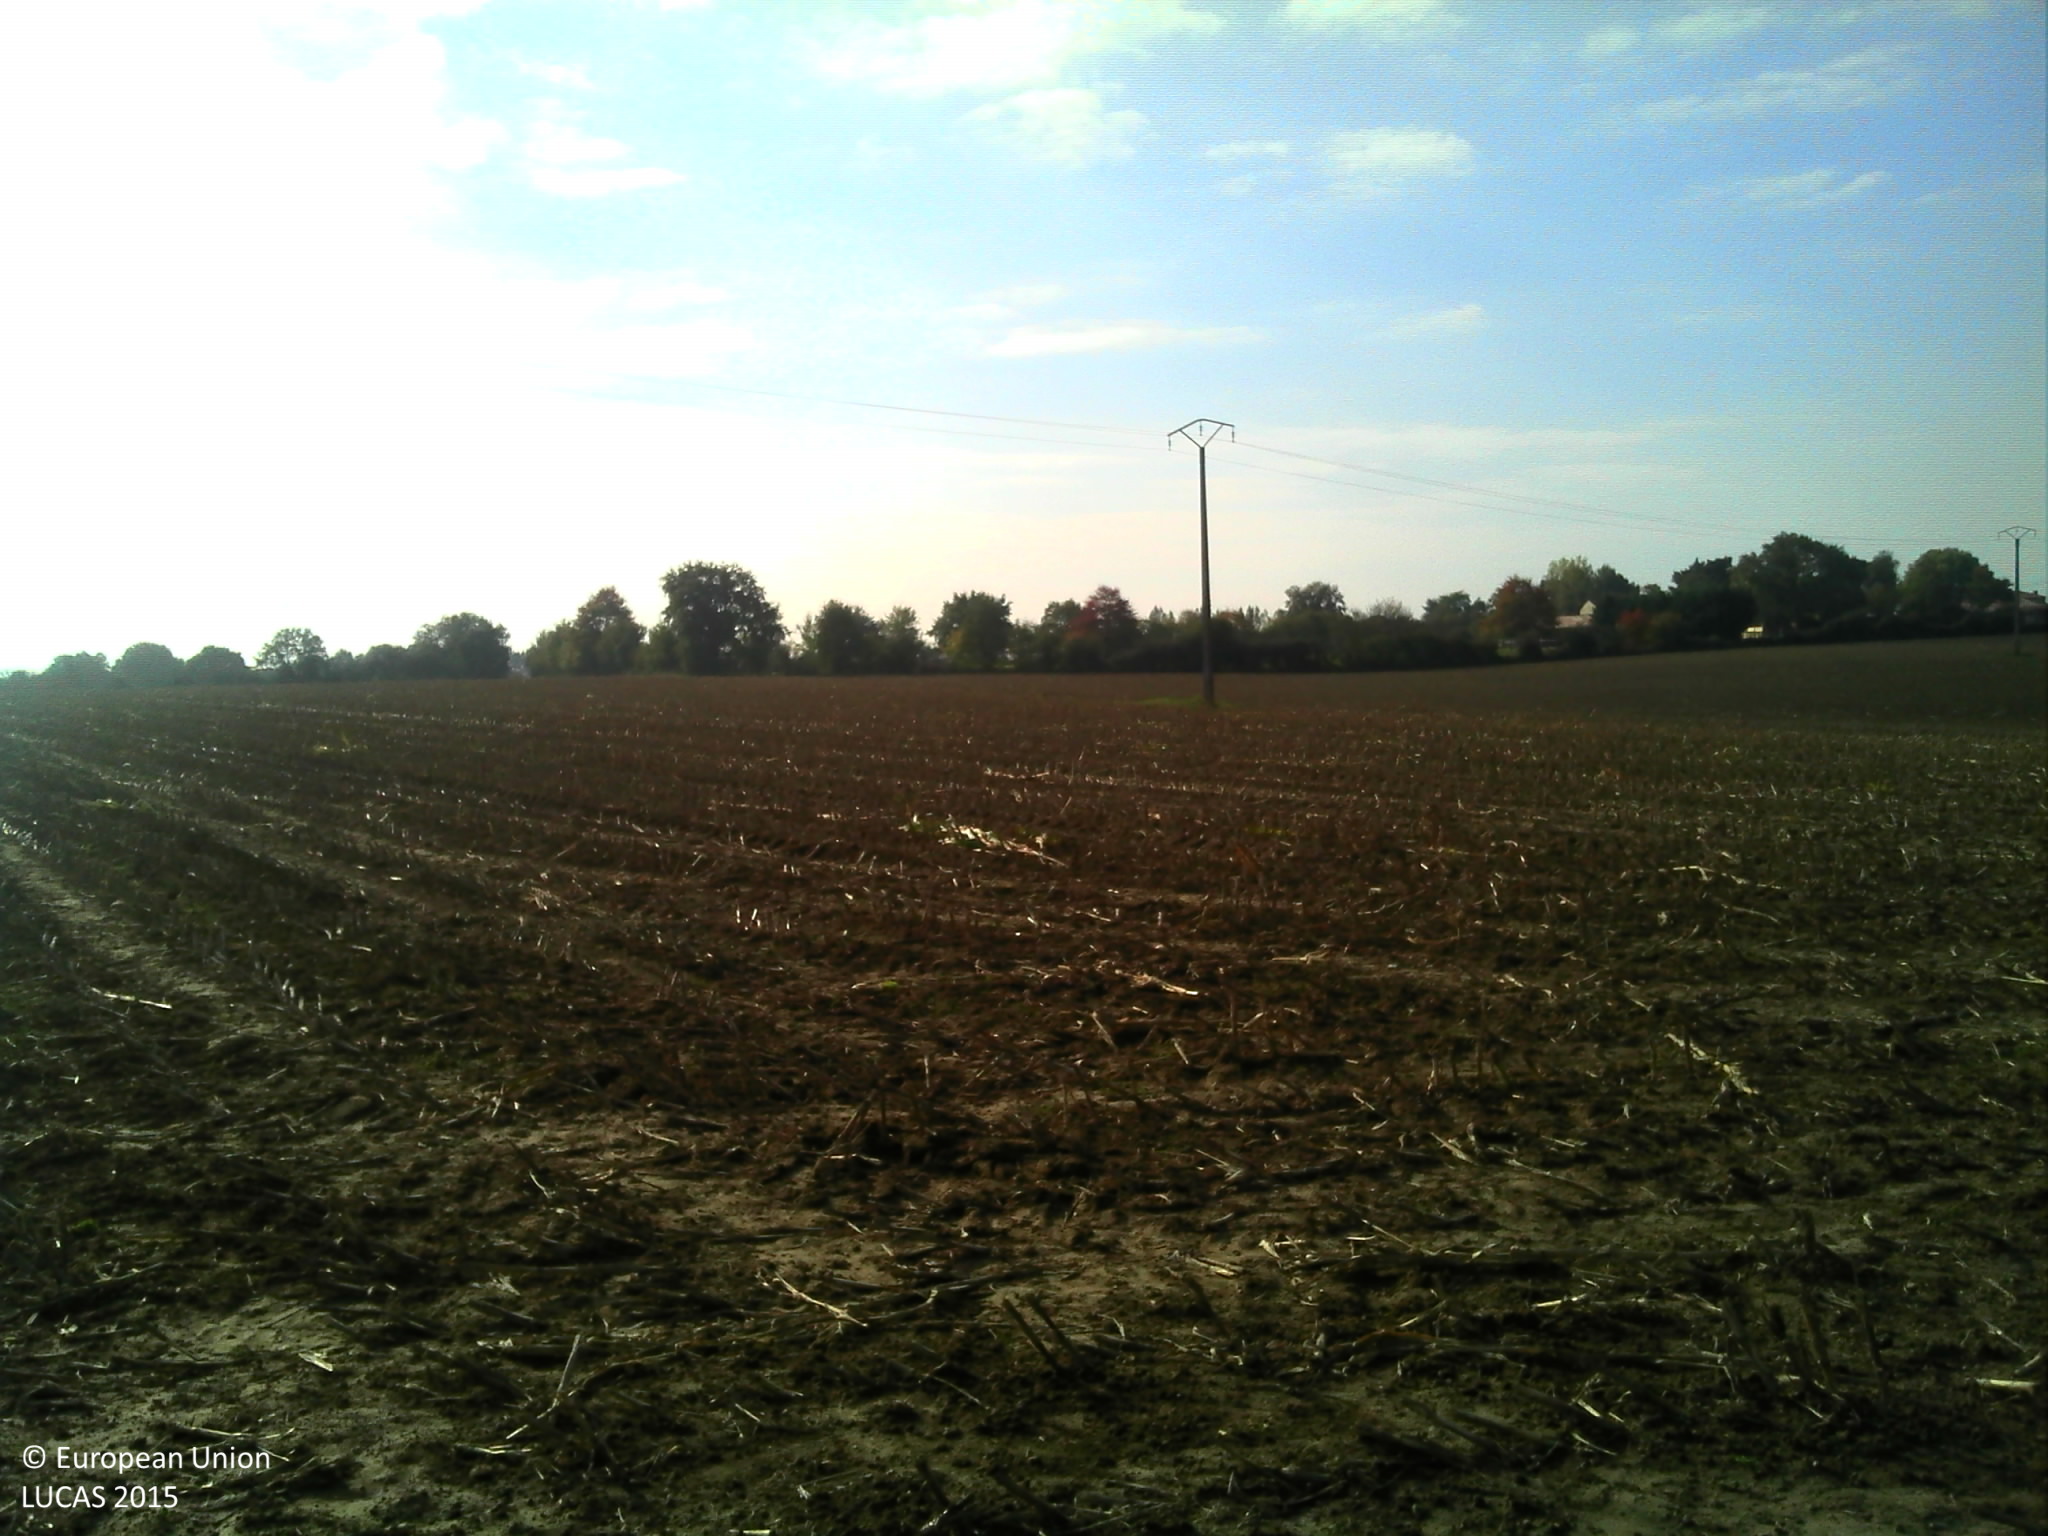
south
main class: Cropland
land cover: Maize
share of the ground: 25 - 50 %
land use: Agriculture (excluding fallow land and kitchen gardens)
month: October
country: FR
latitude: 47.1328
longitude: -0.9372
